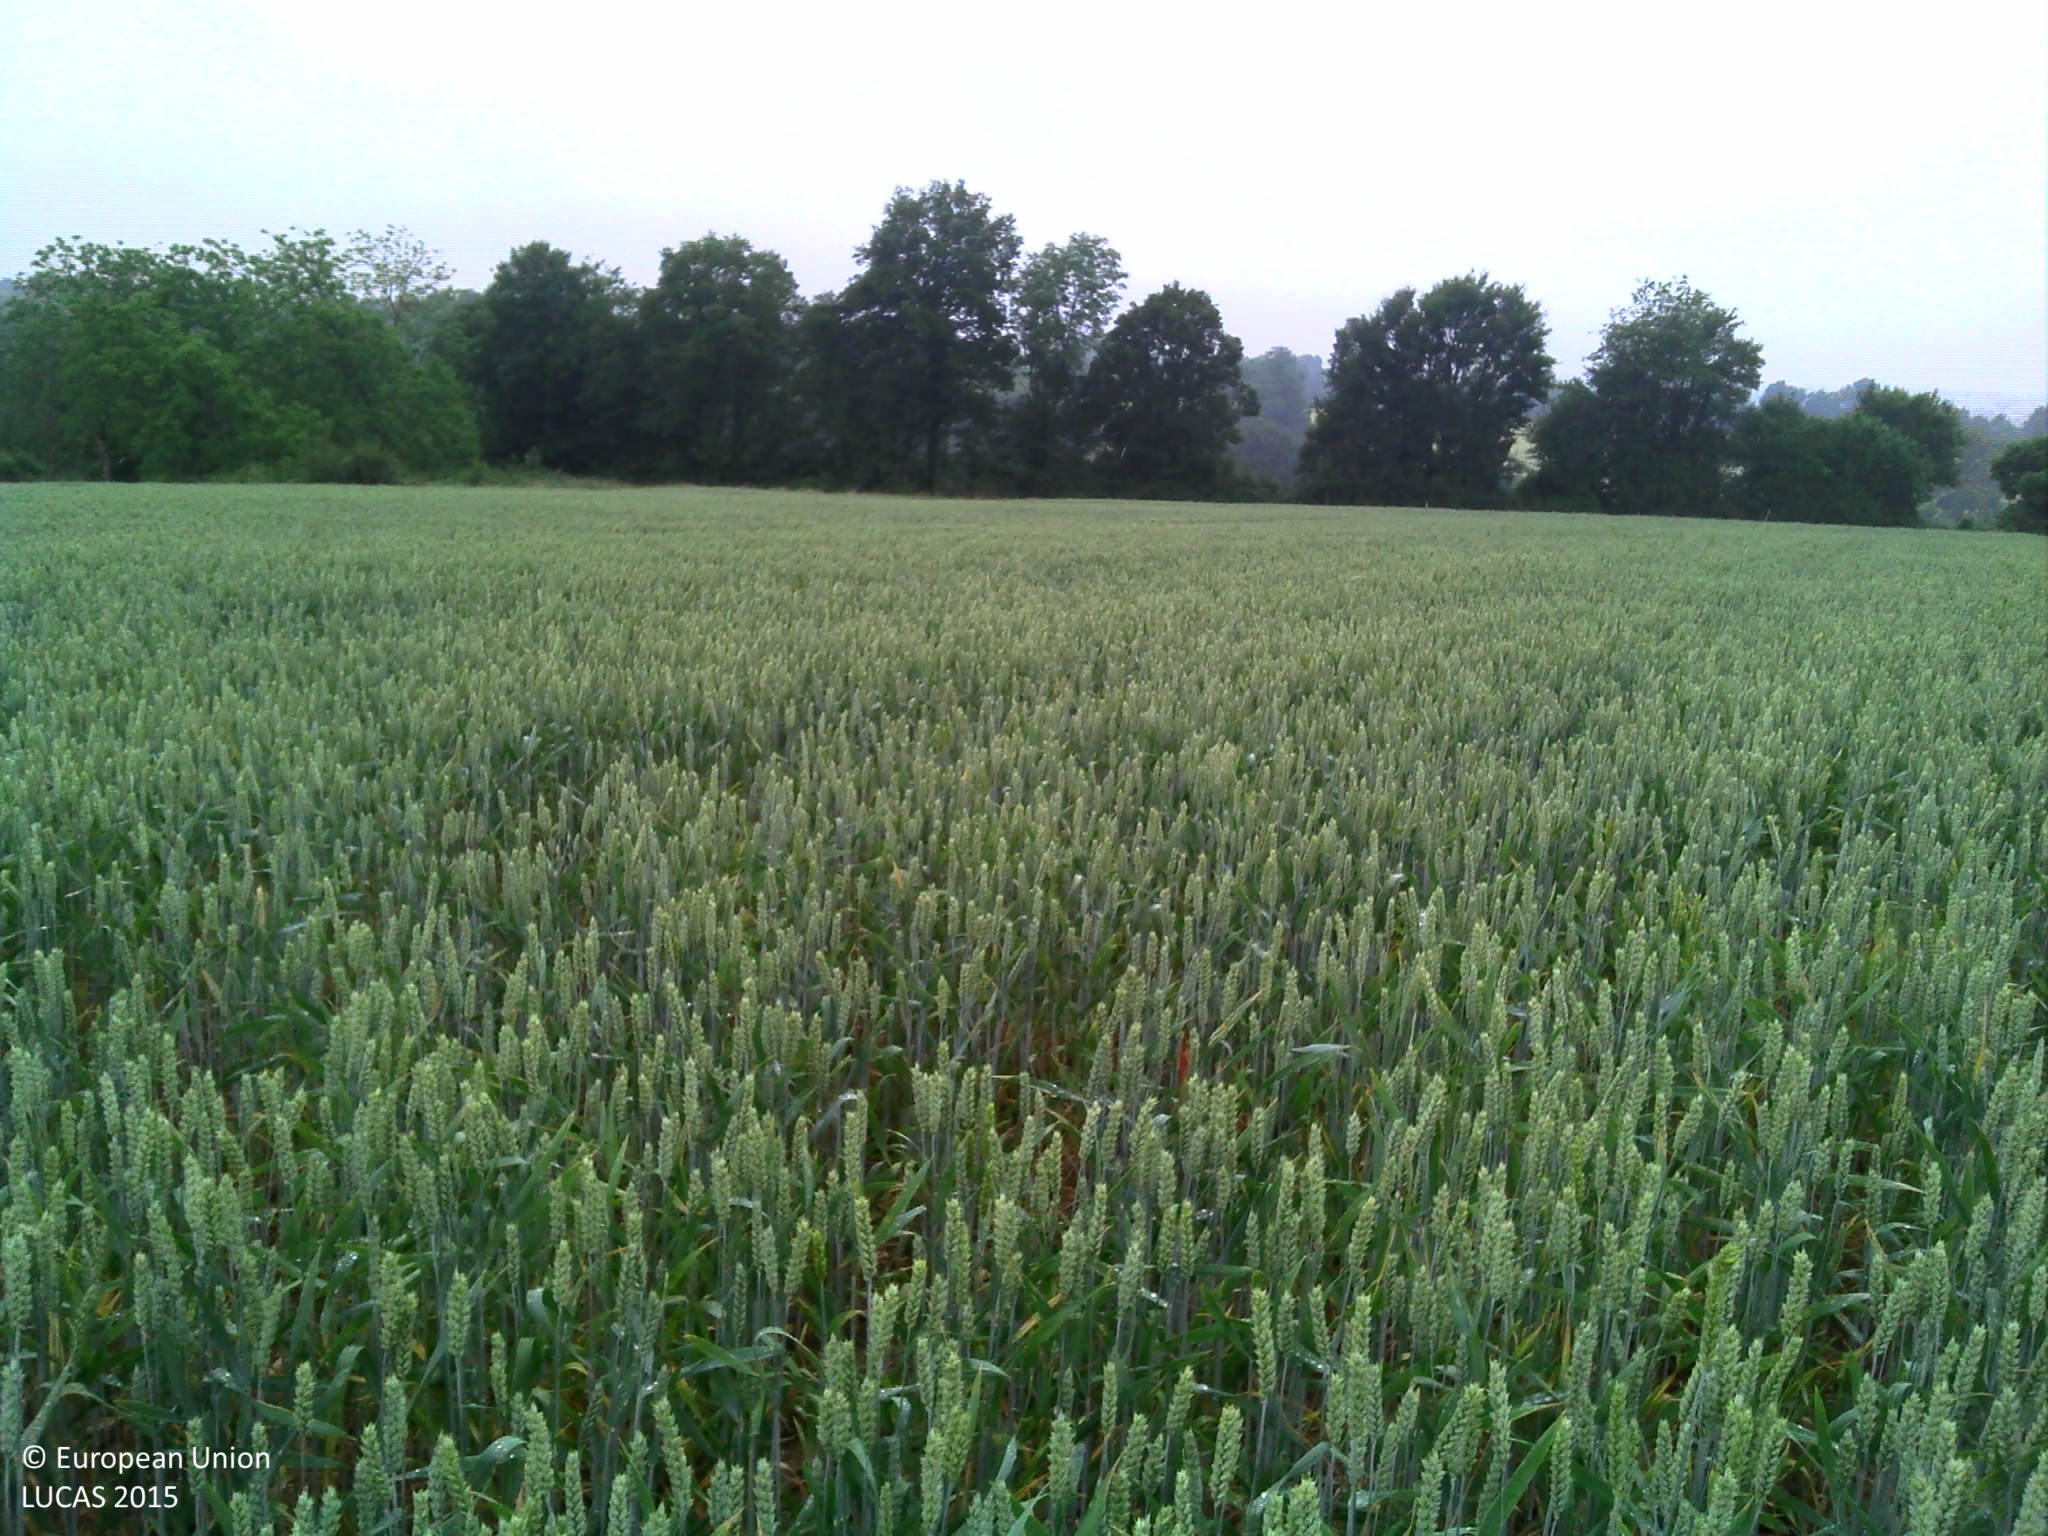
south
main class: Cropland
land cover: Common wheat
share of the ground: > 75 %
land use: Agriculture (excluding fallow land and kitchen gardens)
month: June
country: FR
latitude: 47.5207
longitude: 2.5685
